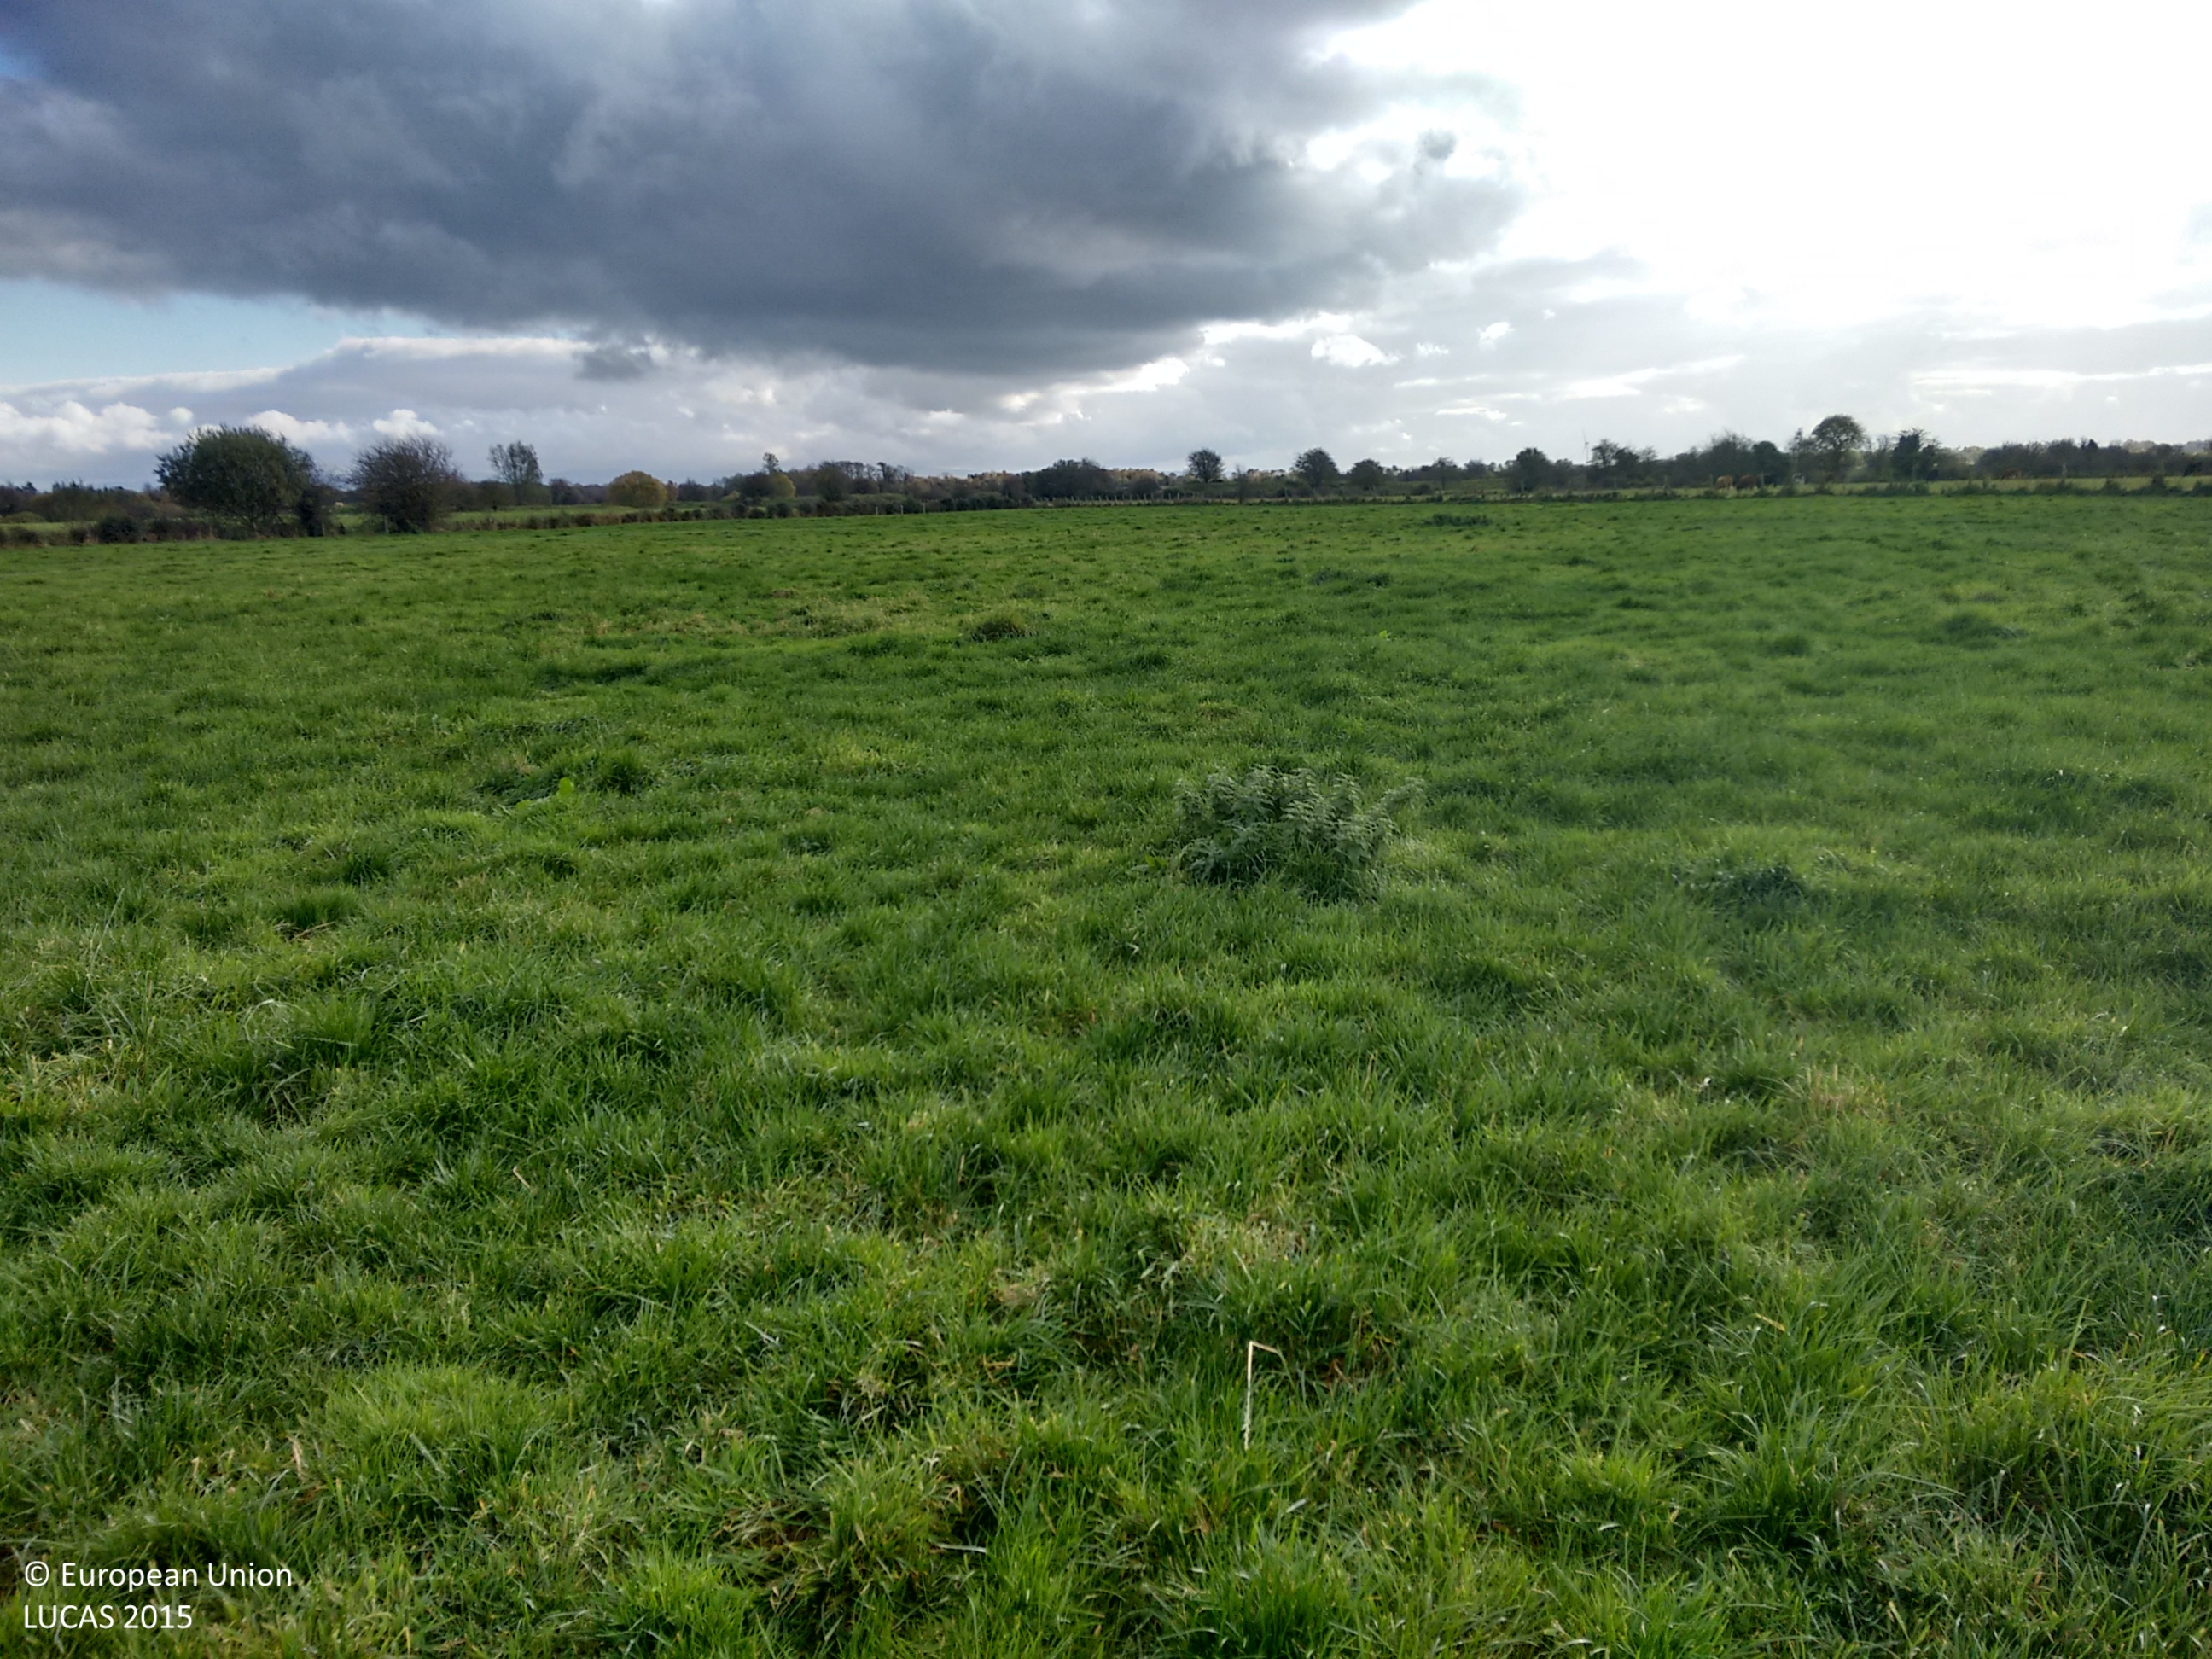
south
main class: Grassland
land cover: Grassland without tree/shrub cover
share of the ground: > 75 %
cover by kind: herbaceous plants 100 %
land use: Agriculture (excluding fallow land and kitchen gardens)
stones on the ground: < 10 %
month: October
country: IE
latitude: 53.2725
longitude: -7.7564
